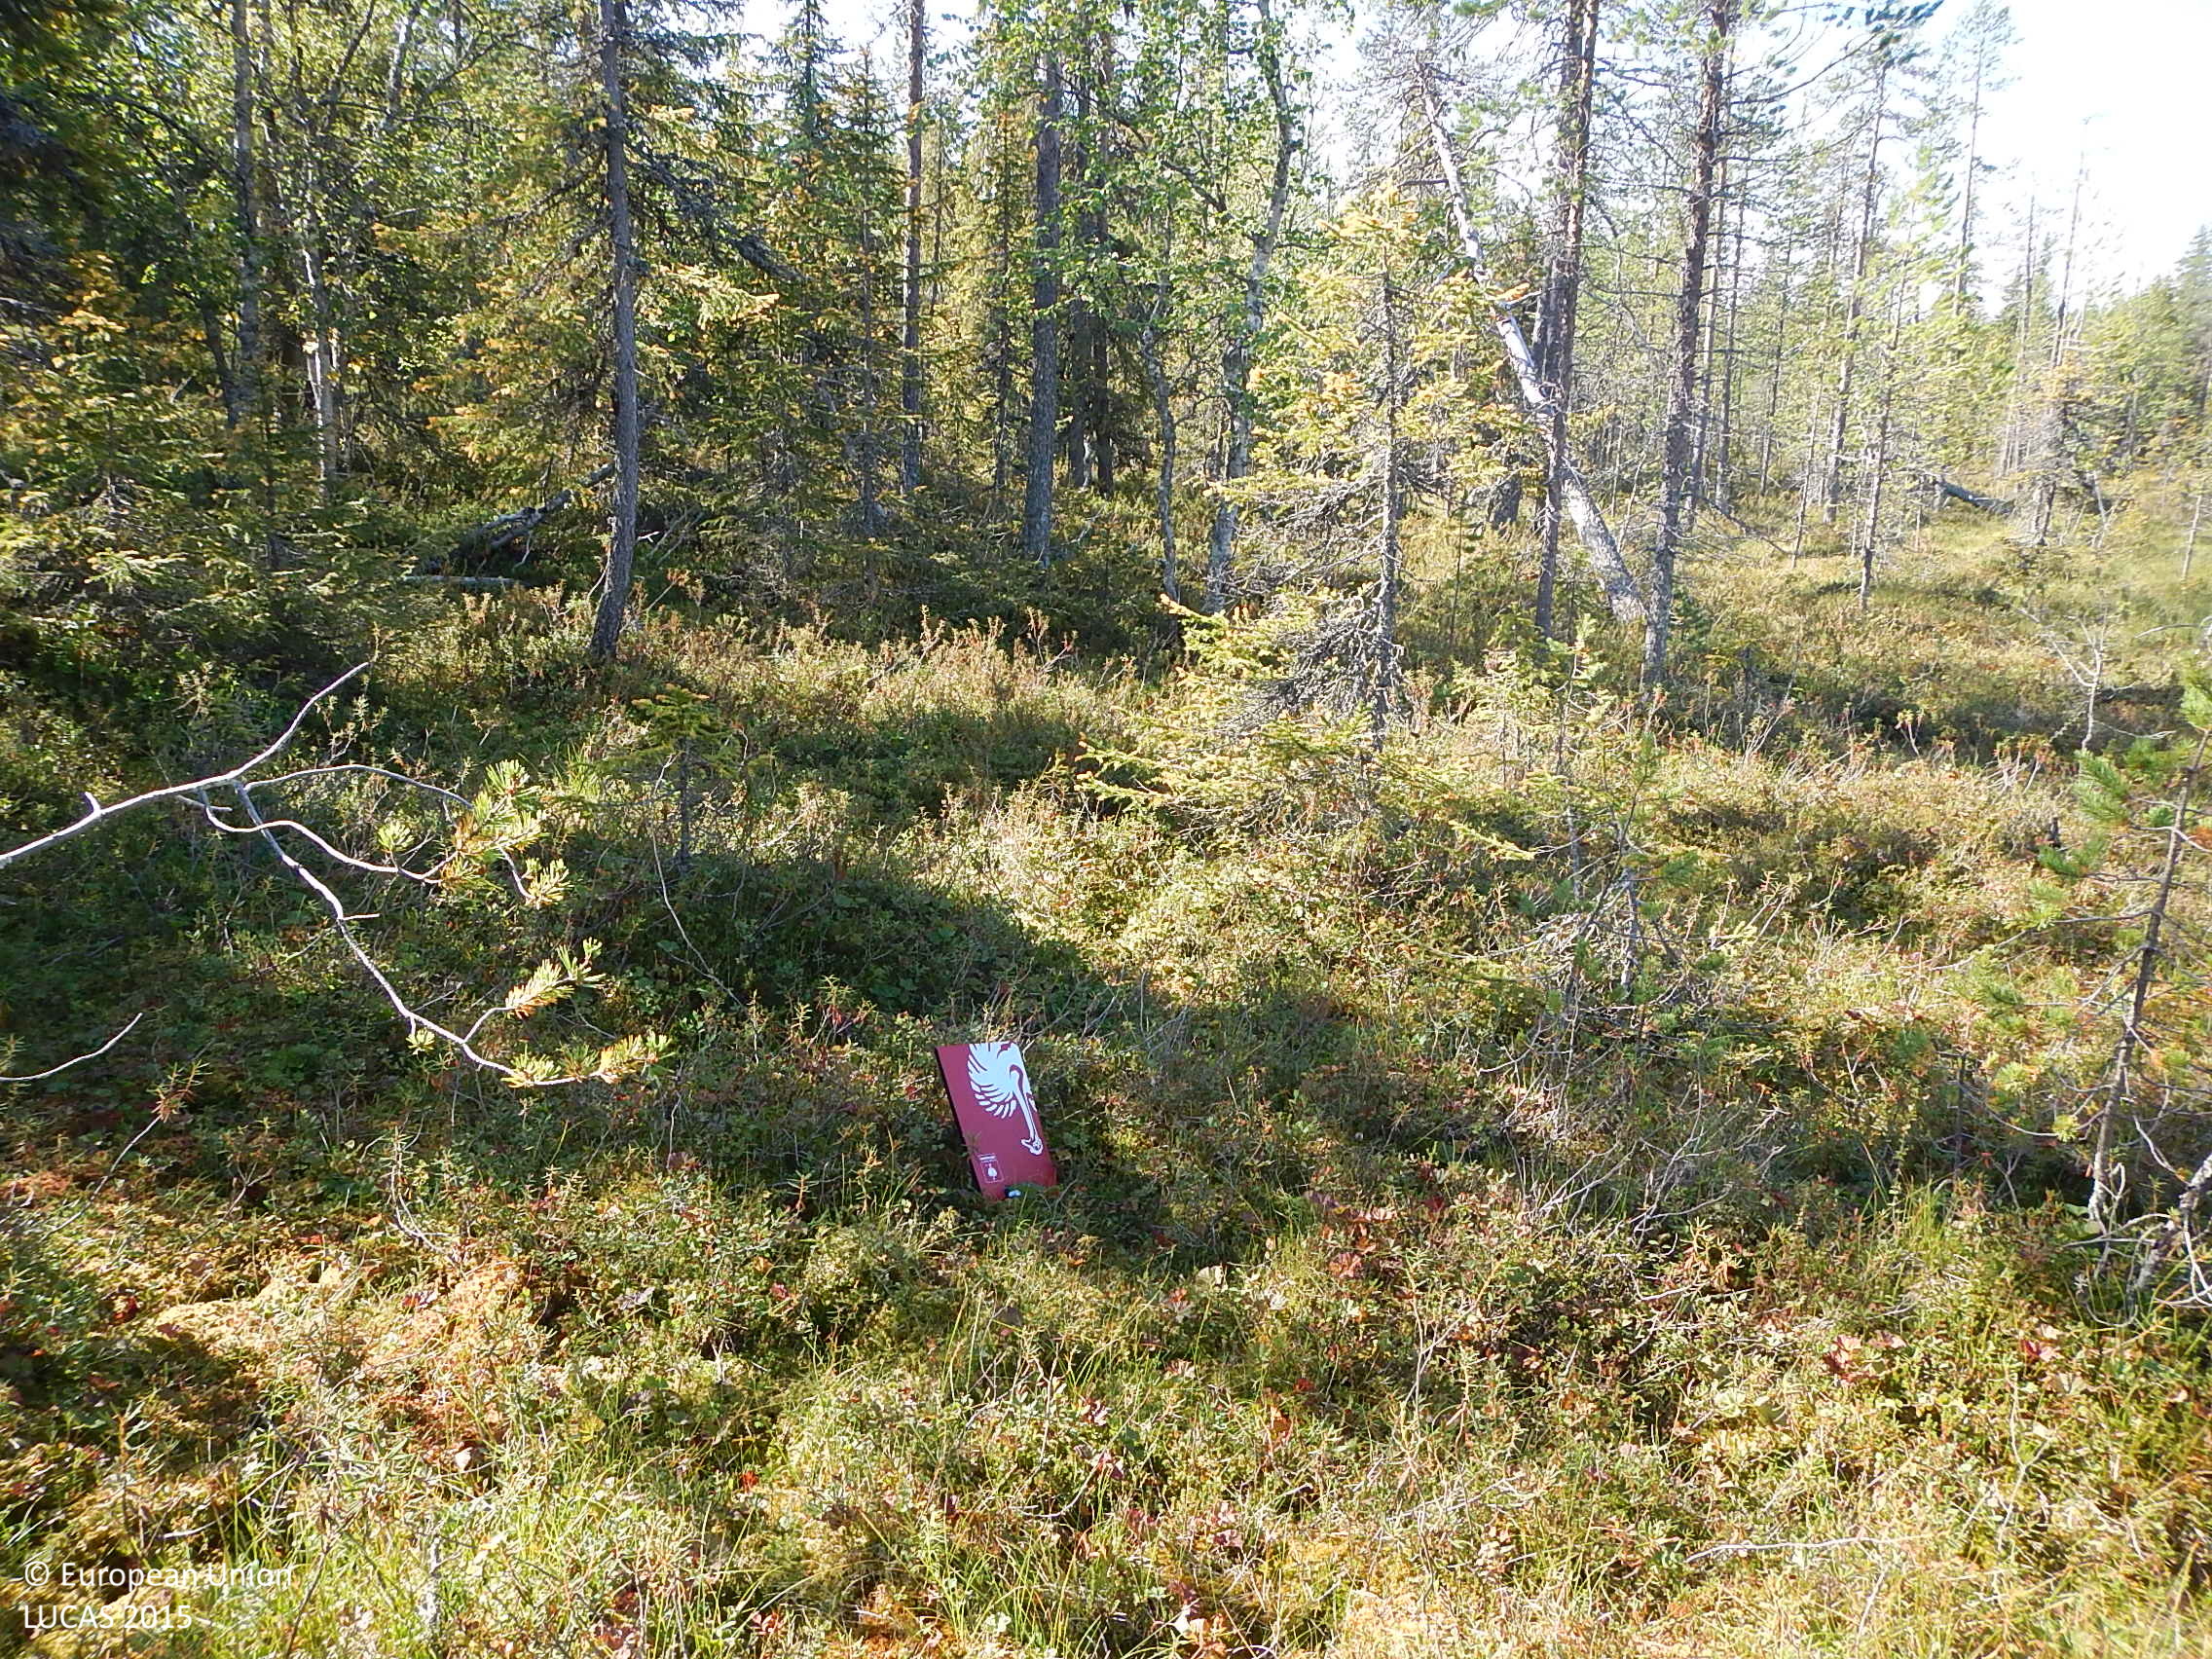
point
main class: Woodland
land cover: Other mixed woodland
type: boreal forest
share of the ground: 25 - 50 %
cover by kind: shrubs 40 %, lichens and mosses 20 %, coniferous forest trees 15 %, broadleaved forest trees 15 %, herbaceous plants 10 %
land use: Forestry
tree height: > 5 m
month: August
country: FI
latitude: 66.5257
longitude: 28.2007
